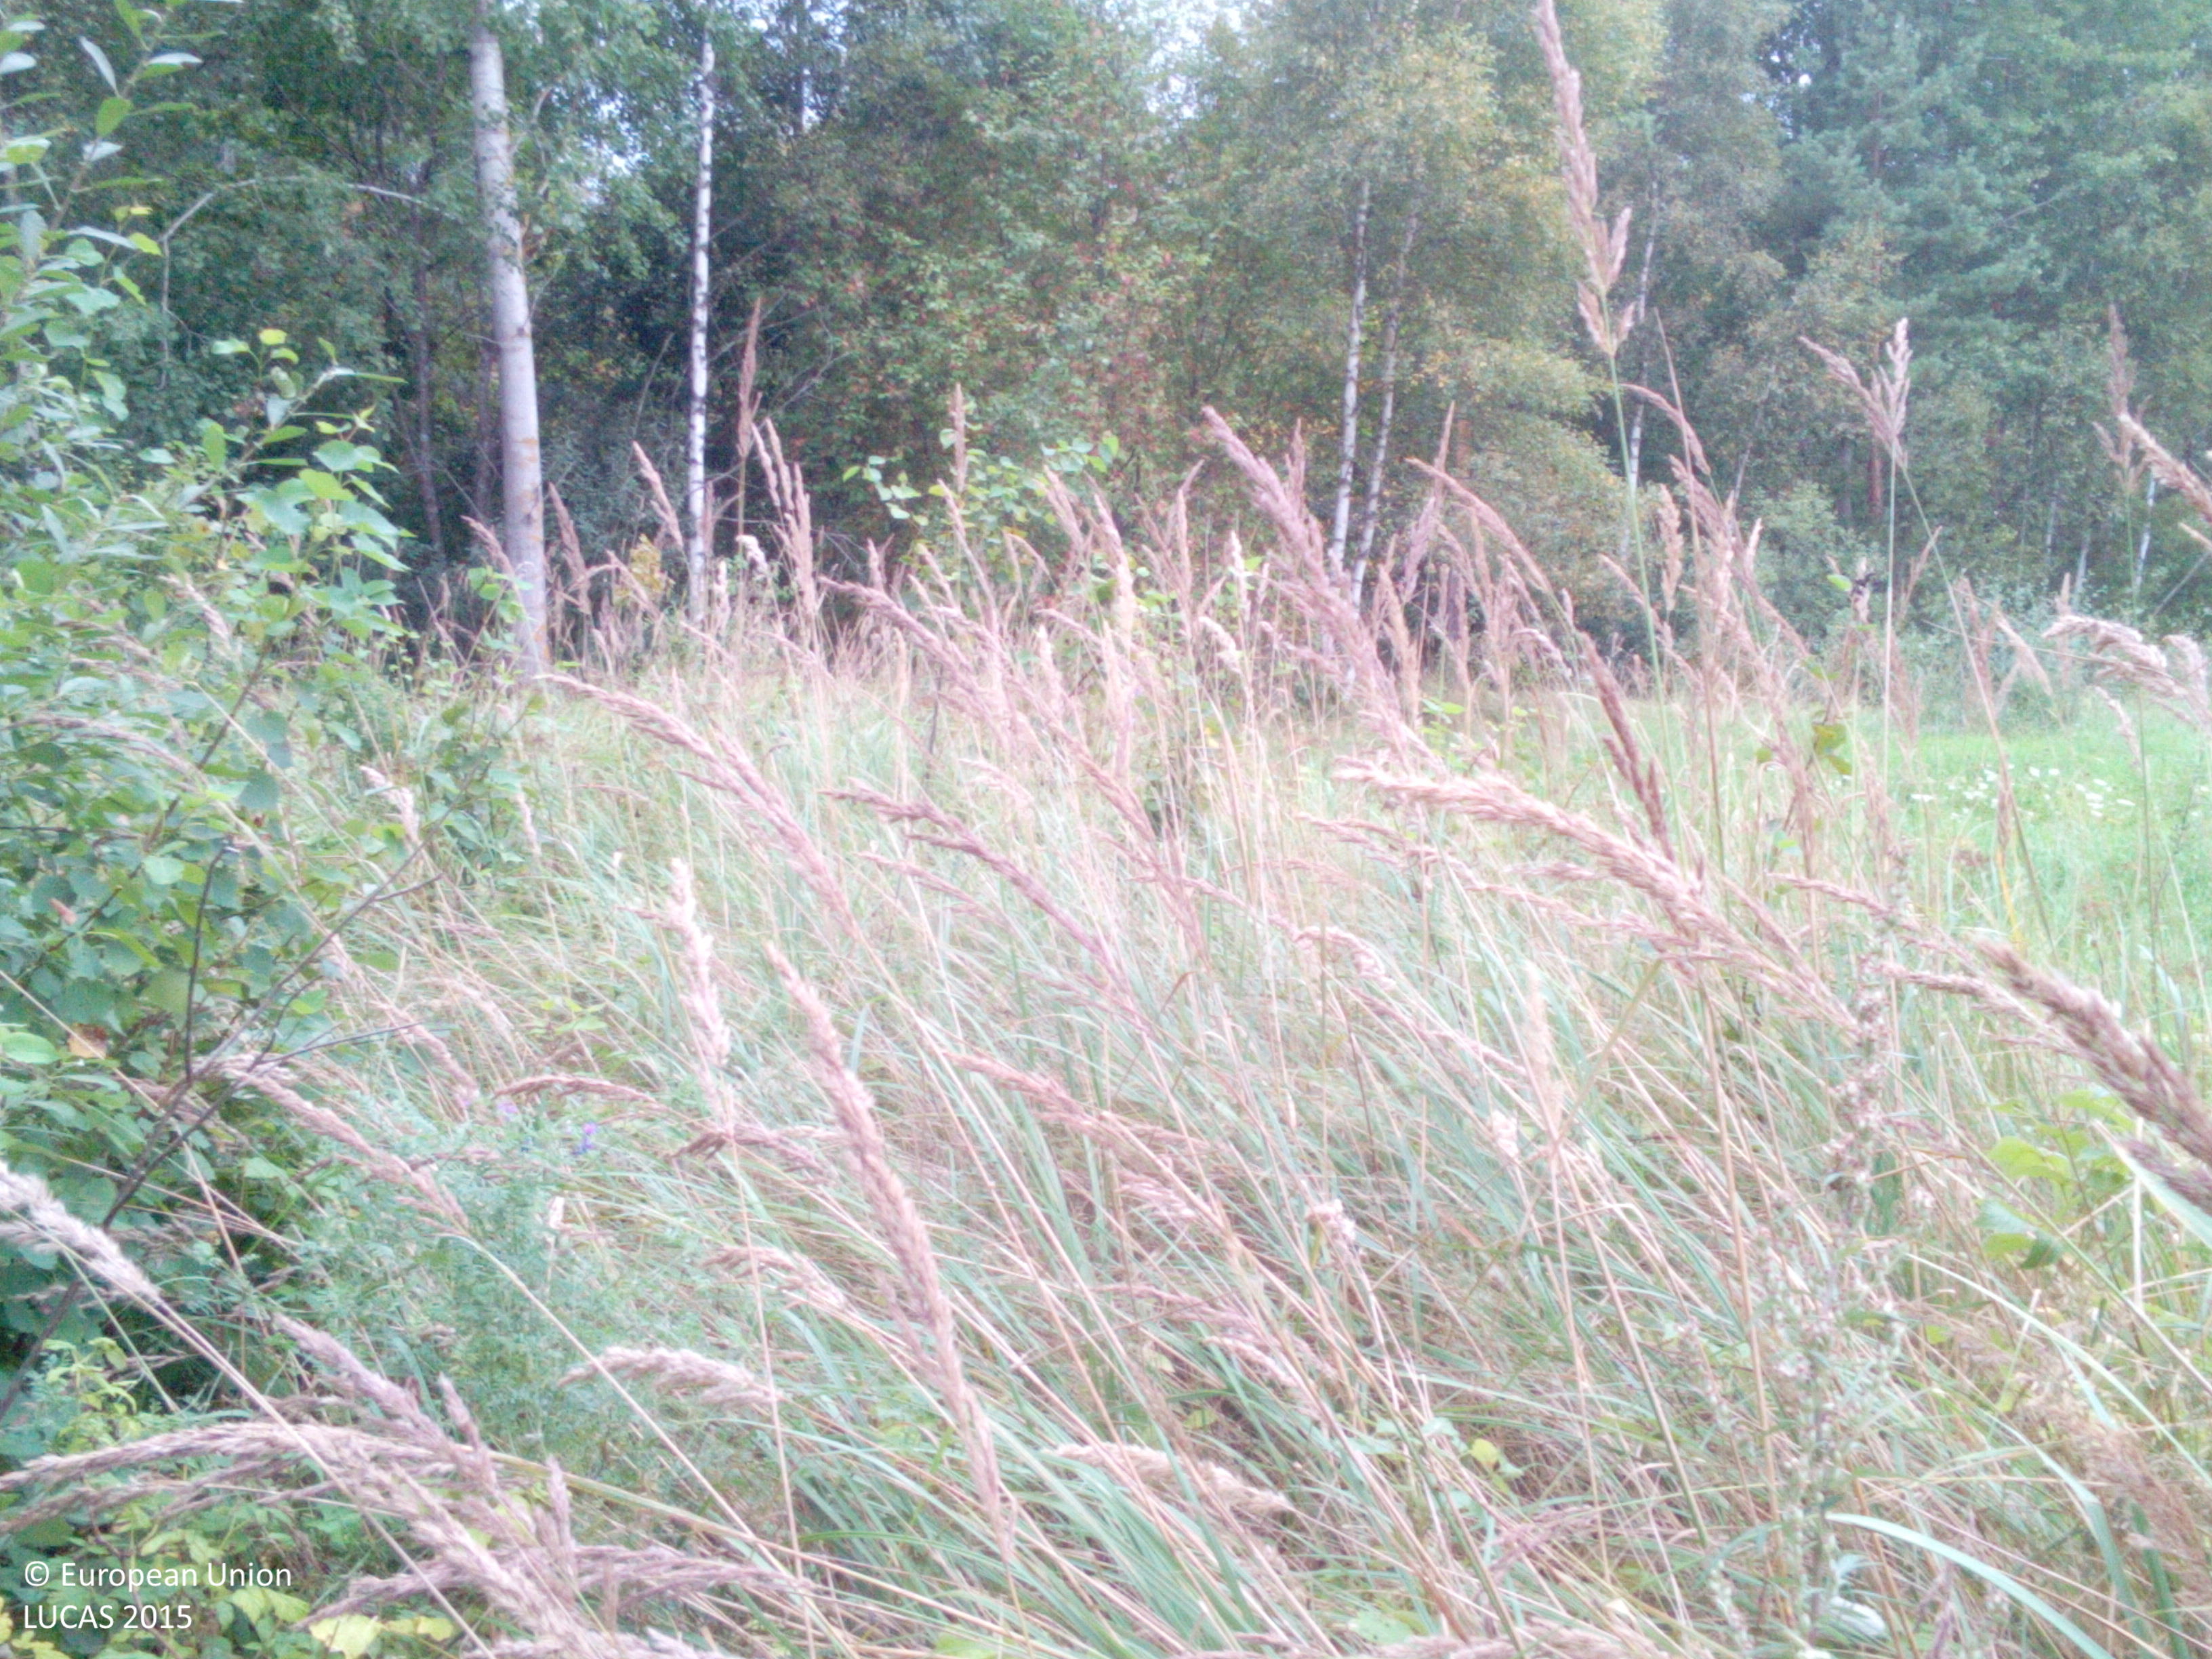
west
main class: Woodland
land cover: Broadleaved woodland
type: non-riverine alder, birch or aspen forest
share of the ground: 25 - 50 %
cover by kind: herbaceous plants 60 %, broadleaved forest trees 40 %
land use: Forestry
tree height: > 5 m
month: August
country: LV
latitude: 56.2064
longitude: 21.1786
